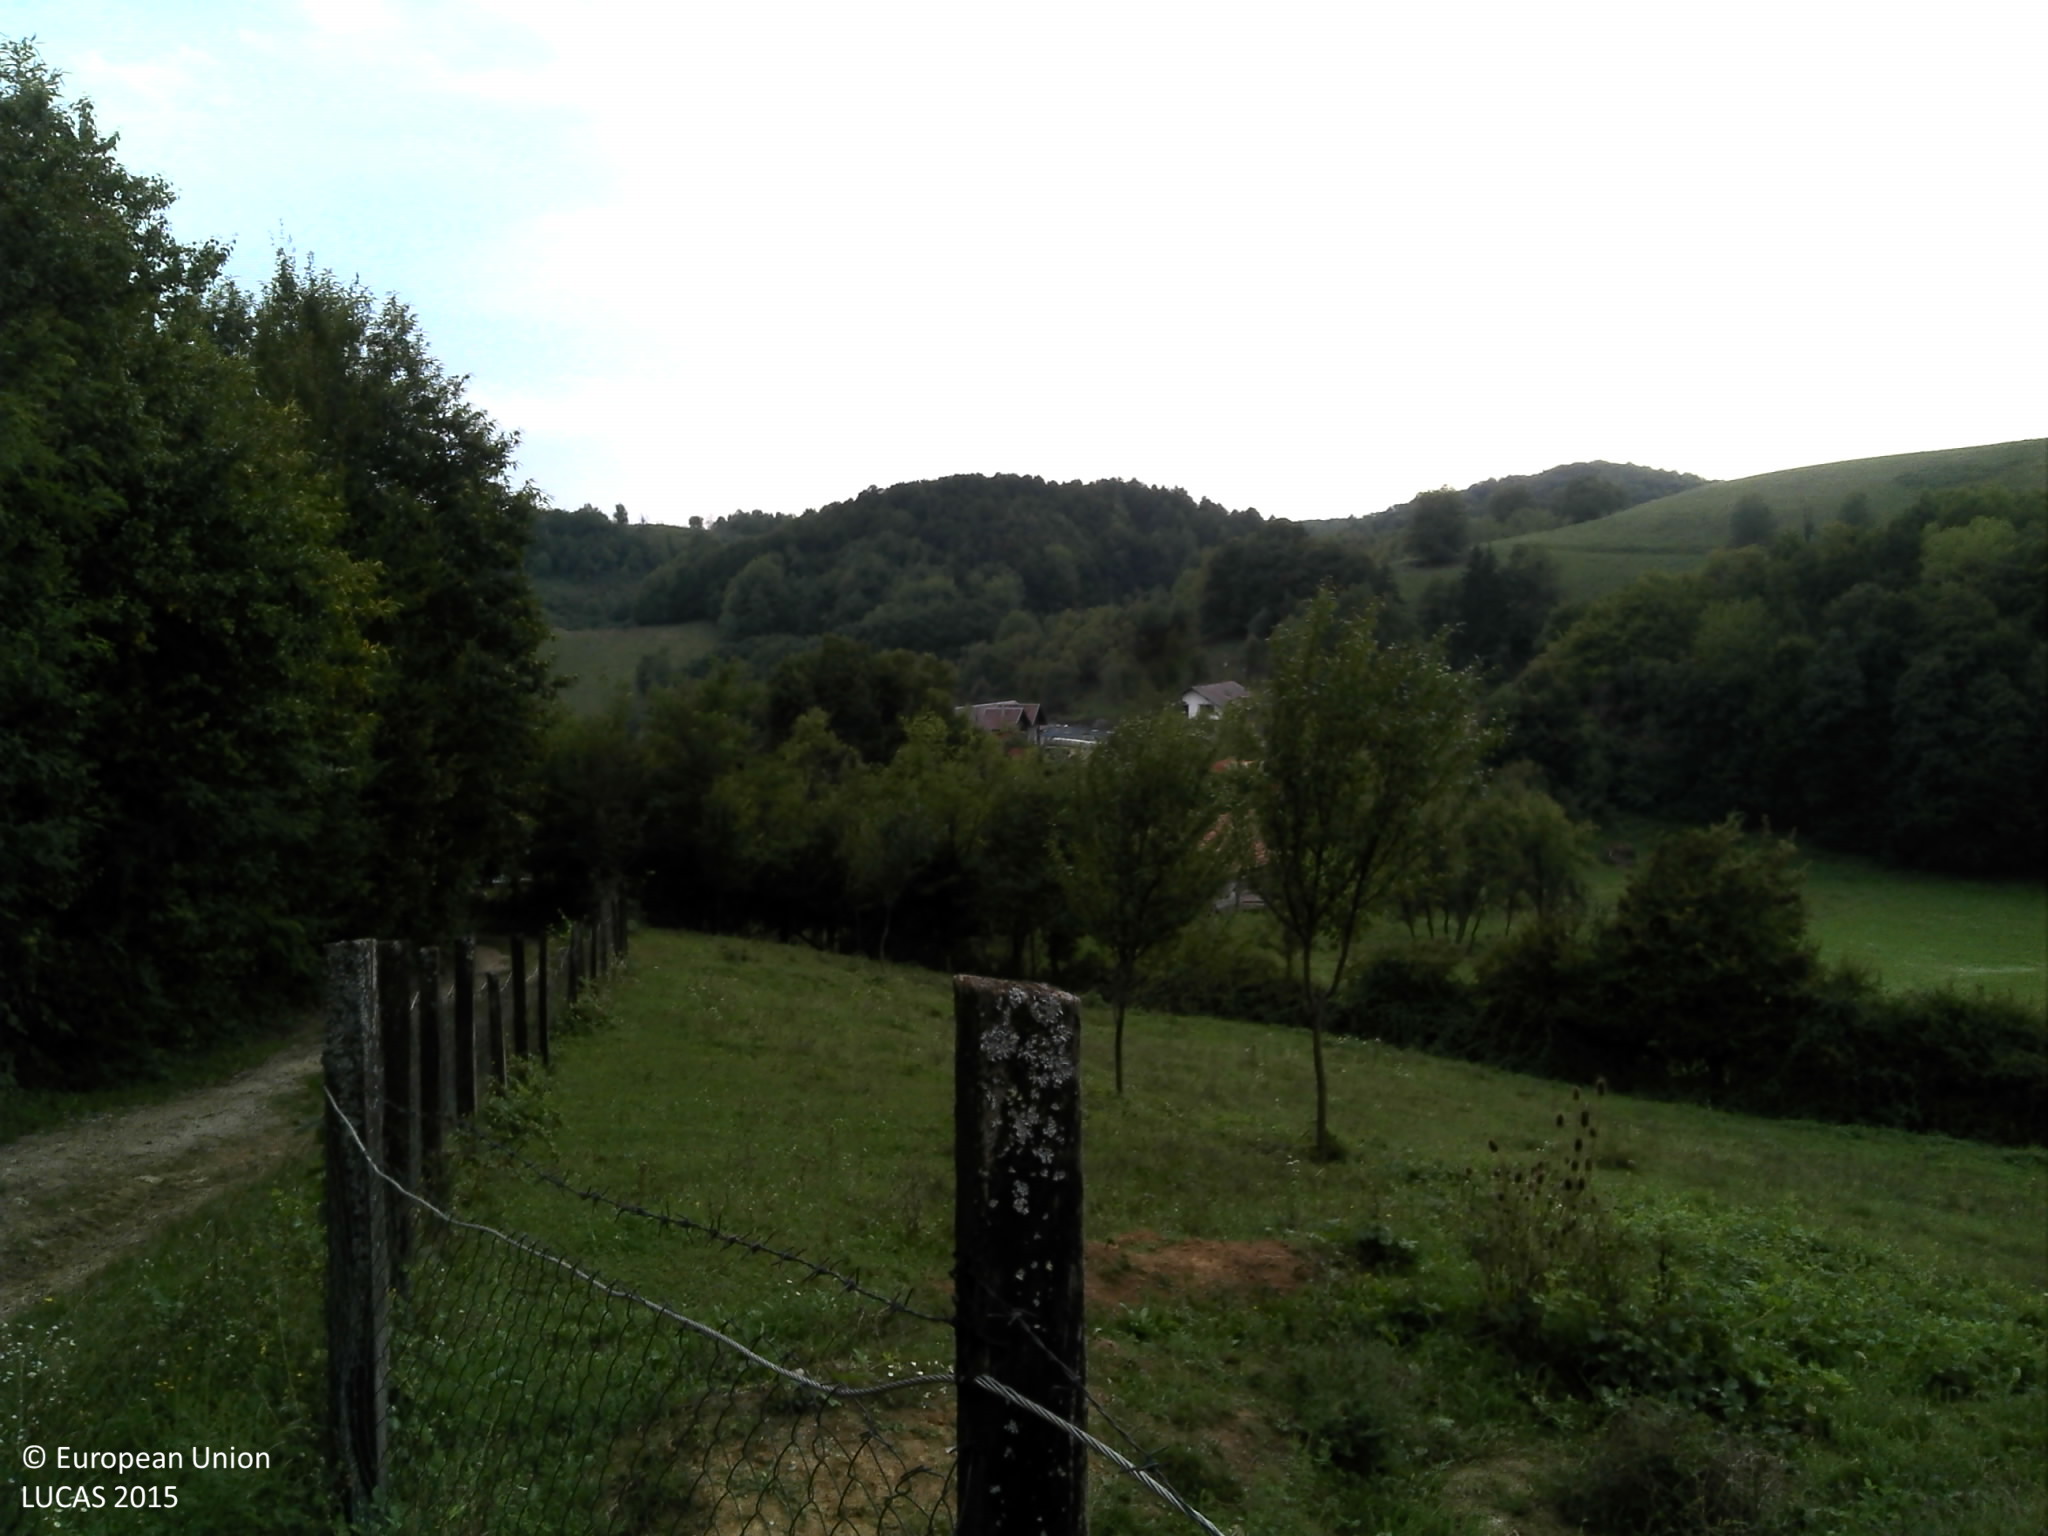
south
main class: Grassland
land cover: Grassland with sparse tree/shrub cover
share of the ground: > 75 %
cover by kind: herbaceous plants 95 %, broadleaved forest trees 5 %
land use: Agriculture (excluding fallow land and kitchen gardens)
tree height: < 5 m
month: September
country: HR
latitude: 45.1721
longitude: 15.6577
